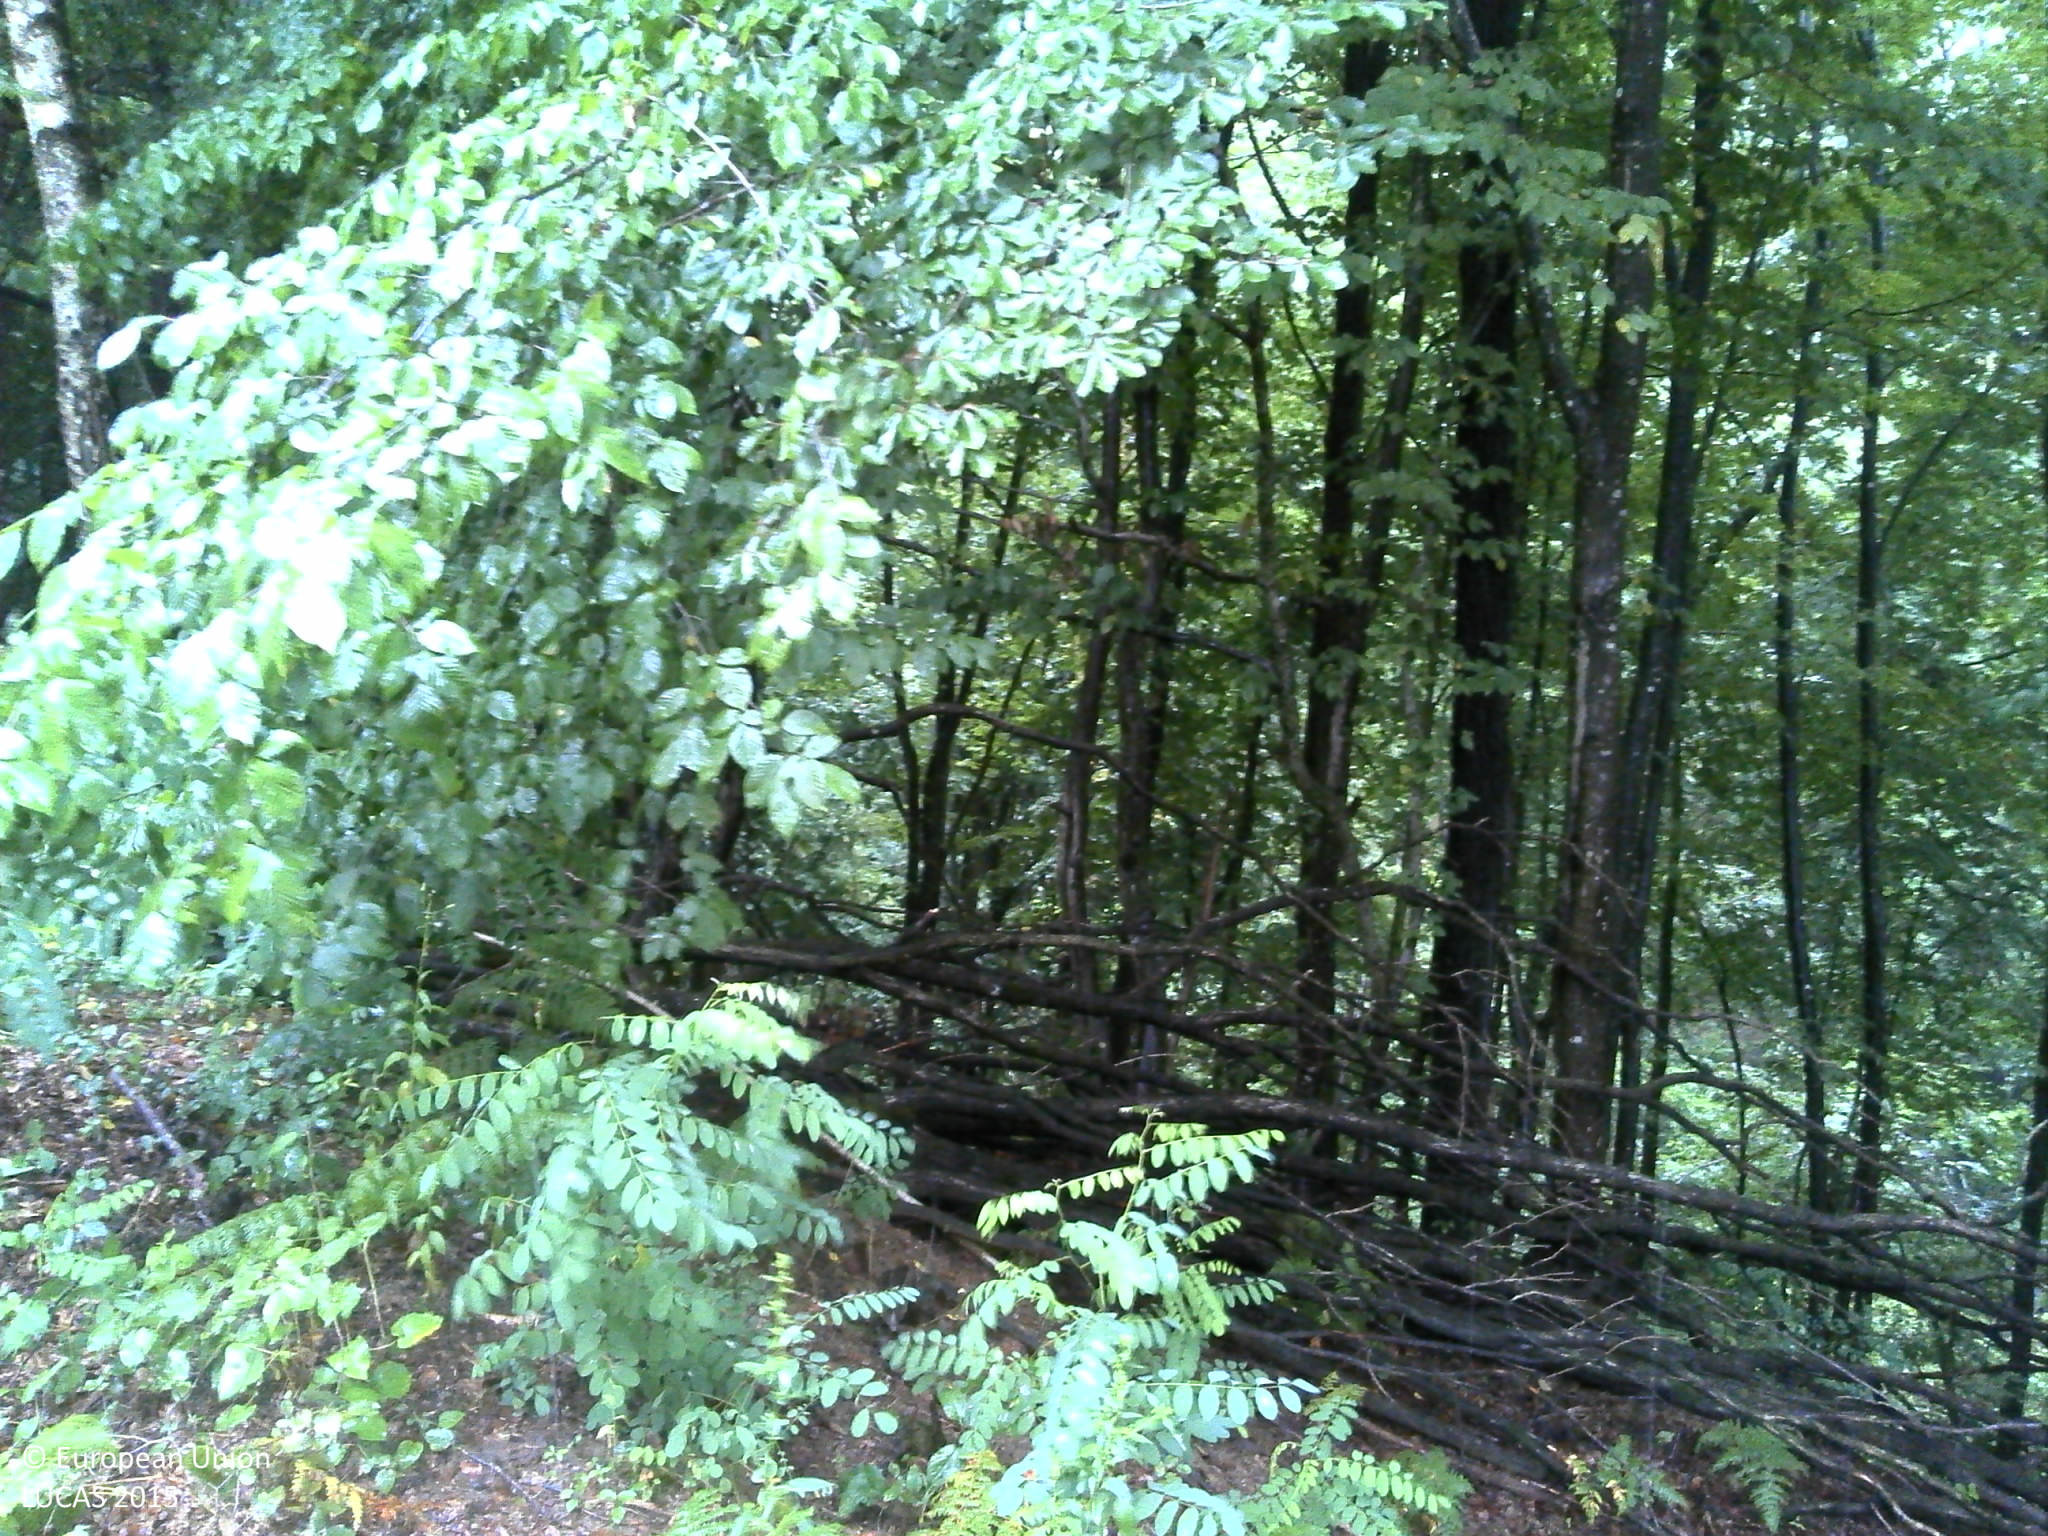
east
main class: Woodland
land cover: Broadleaved woodland
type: beech forest
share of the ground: > 75 %
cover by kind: broadleaved forest trees 100 %
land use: Forestry
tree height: > 5 m
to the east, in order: Broadleaved woodland; Spontaneously vegetated surfaces; Paved roads, cycling and walking lanes; Spontaneously vegetated surfaces; Tracks; Broadleaved woodland
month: August
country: HR
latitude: 45.4761
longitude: 15.7146
